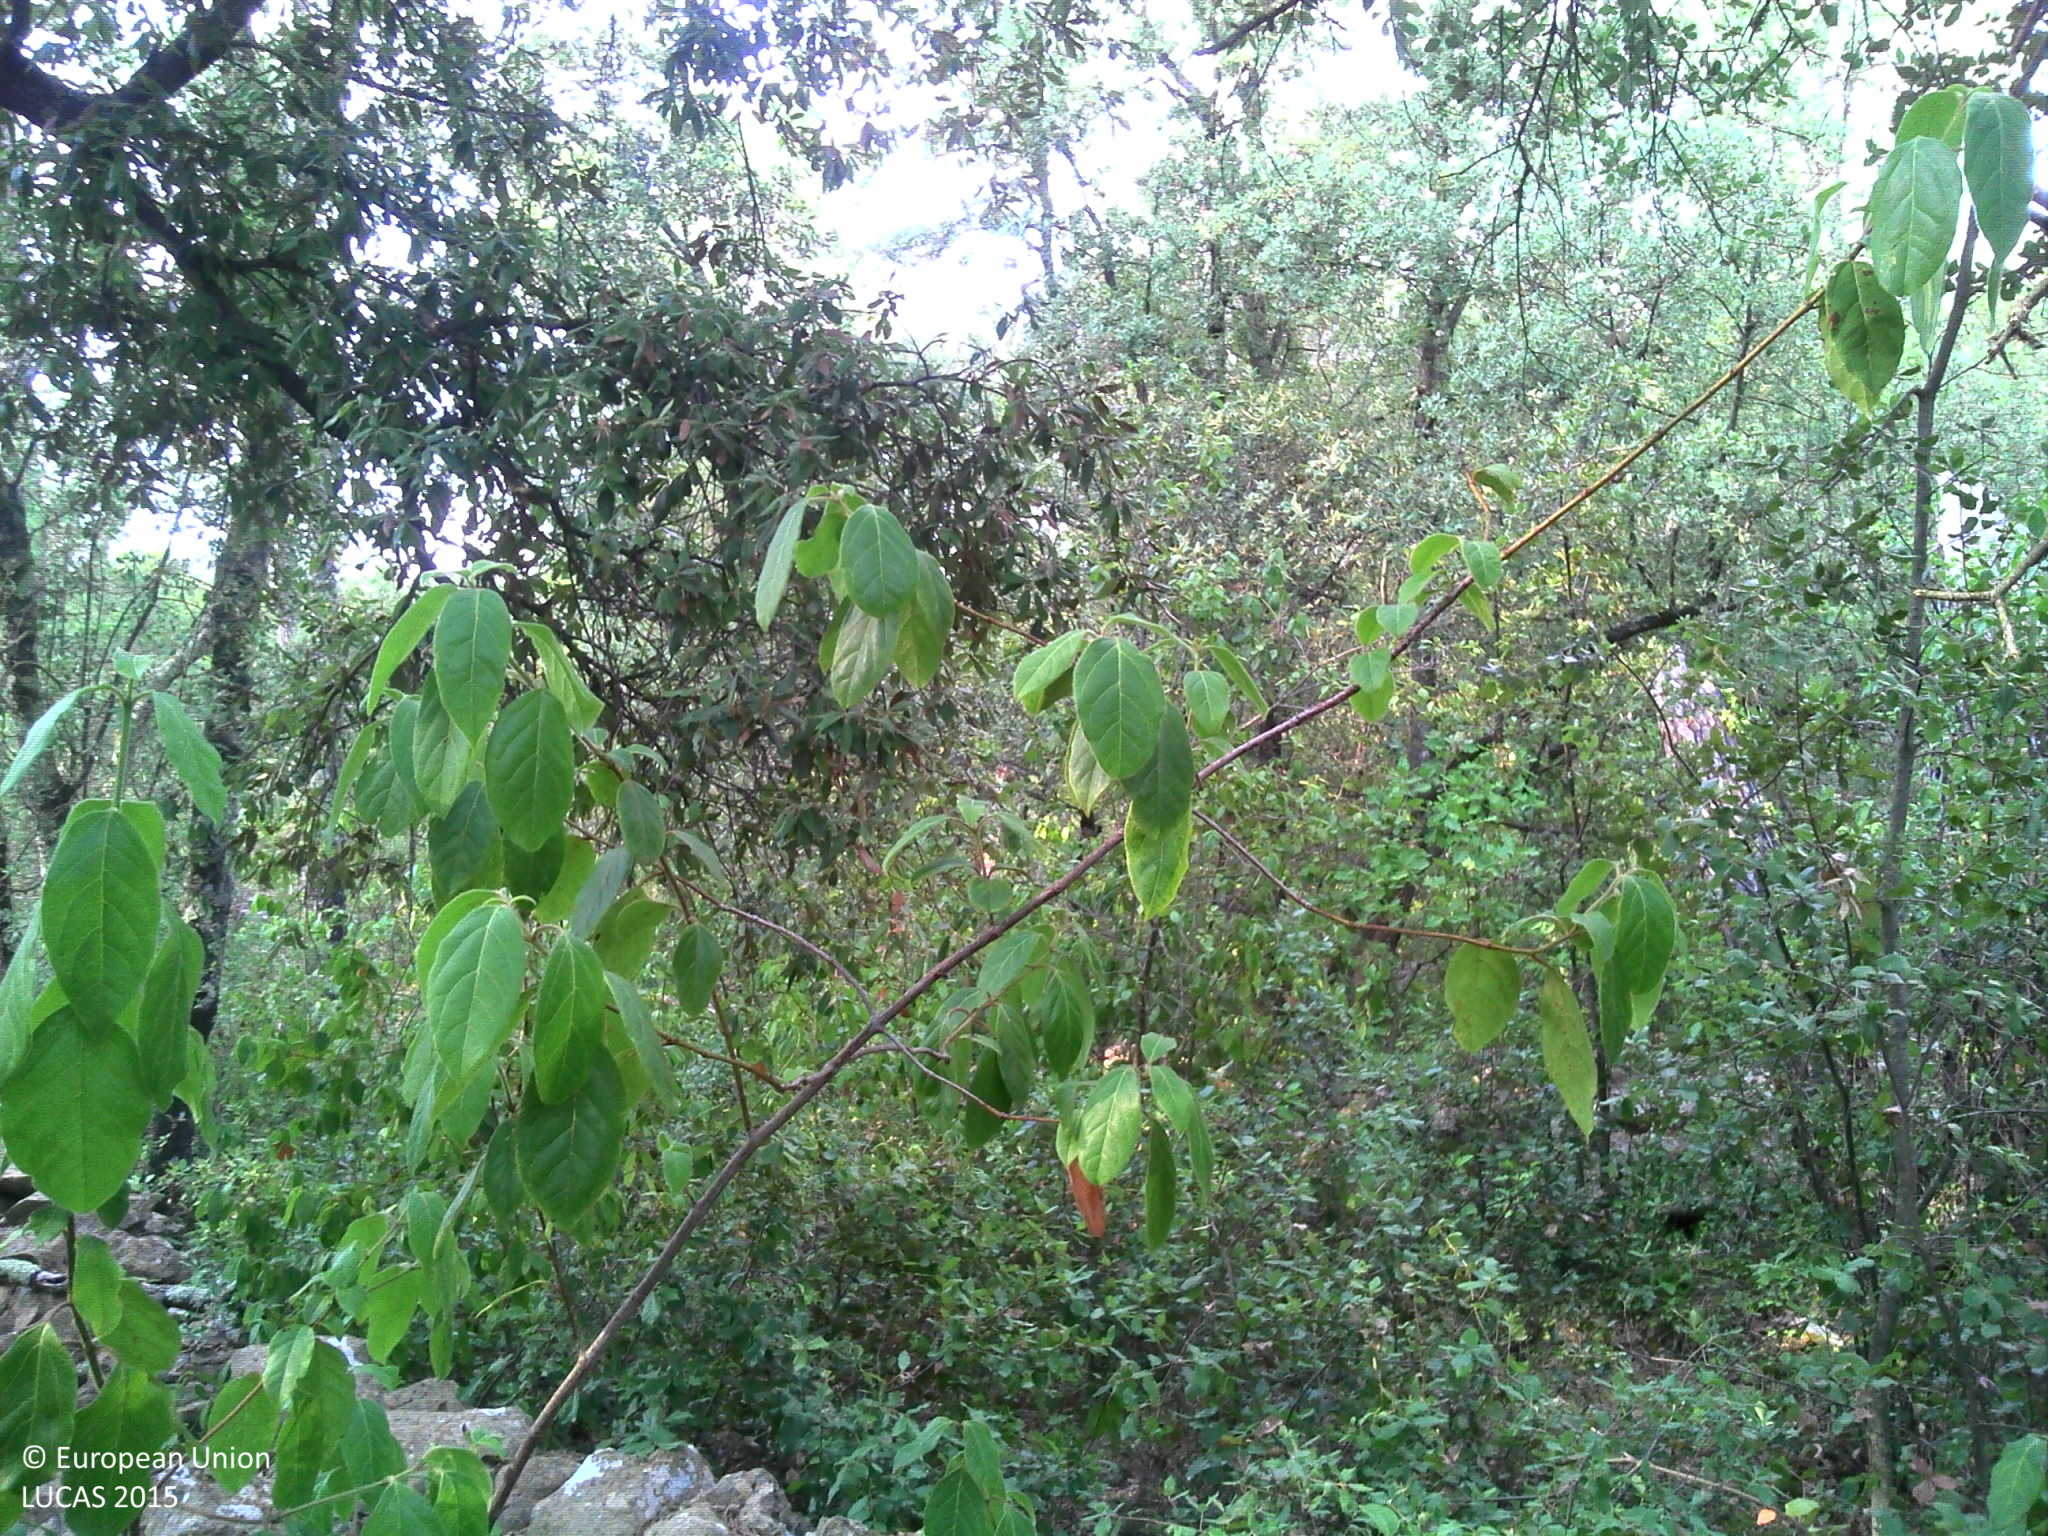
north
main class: Woodland
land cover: Pine dominated mixed woodland
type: coniferous forest of the mediterranean region
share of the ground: > 75 %
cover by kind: broadleaved forest trees 50 %, coniferous forest trees 25 %, shrubs 15 %, unconsolidated bare surface 10 %
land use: Semi-natural and natural areas not in use
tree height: > 5 m
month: August
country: FR
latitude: 43.5093
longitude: 6.3350
